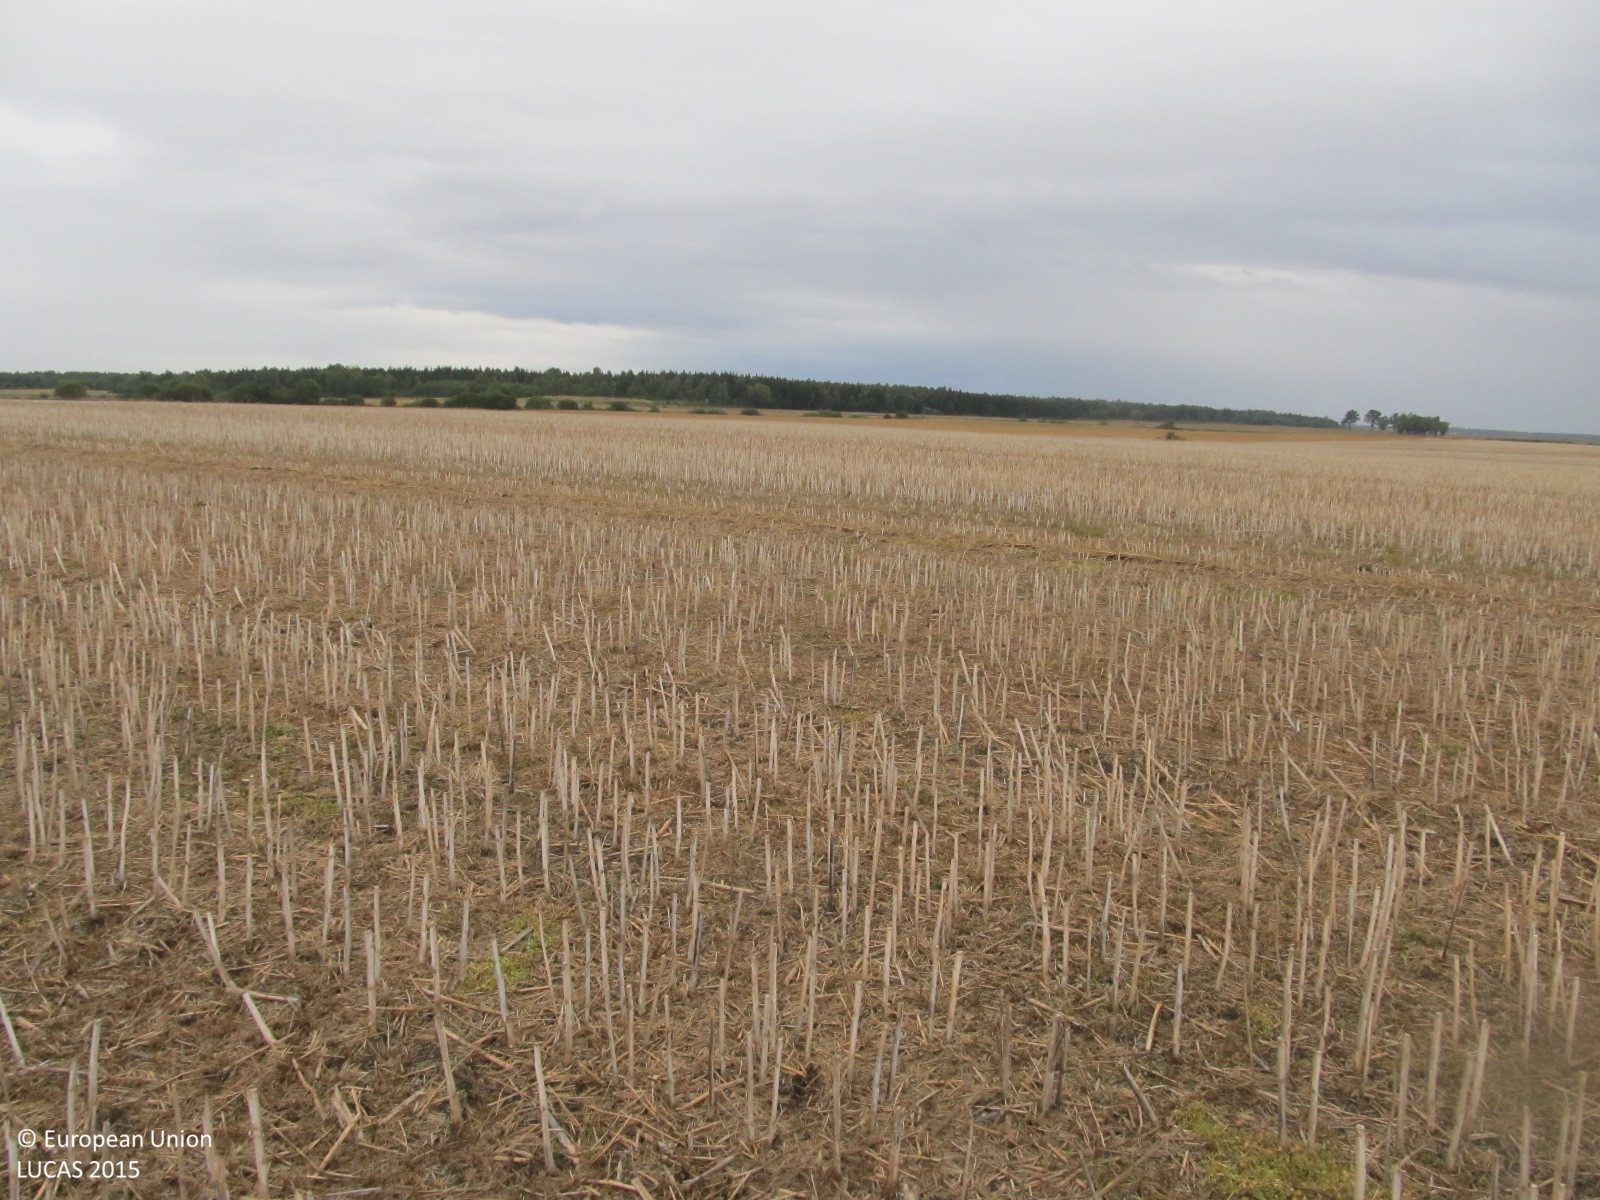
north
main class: Cropland
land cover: Rape and turnip rape
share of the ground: > 75 %
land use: Agriculture (excluding fallow land and kitchen gardens)
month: September
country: LT
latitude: 56.1034
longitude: 23.2067
